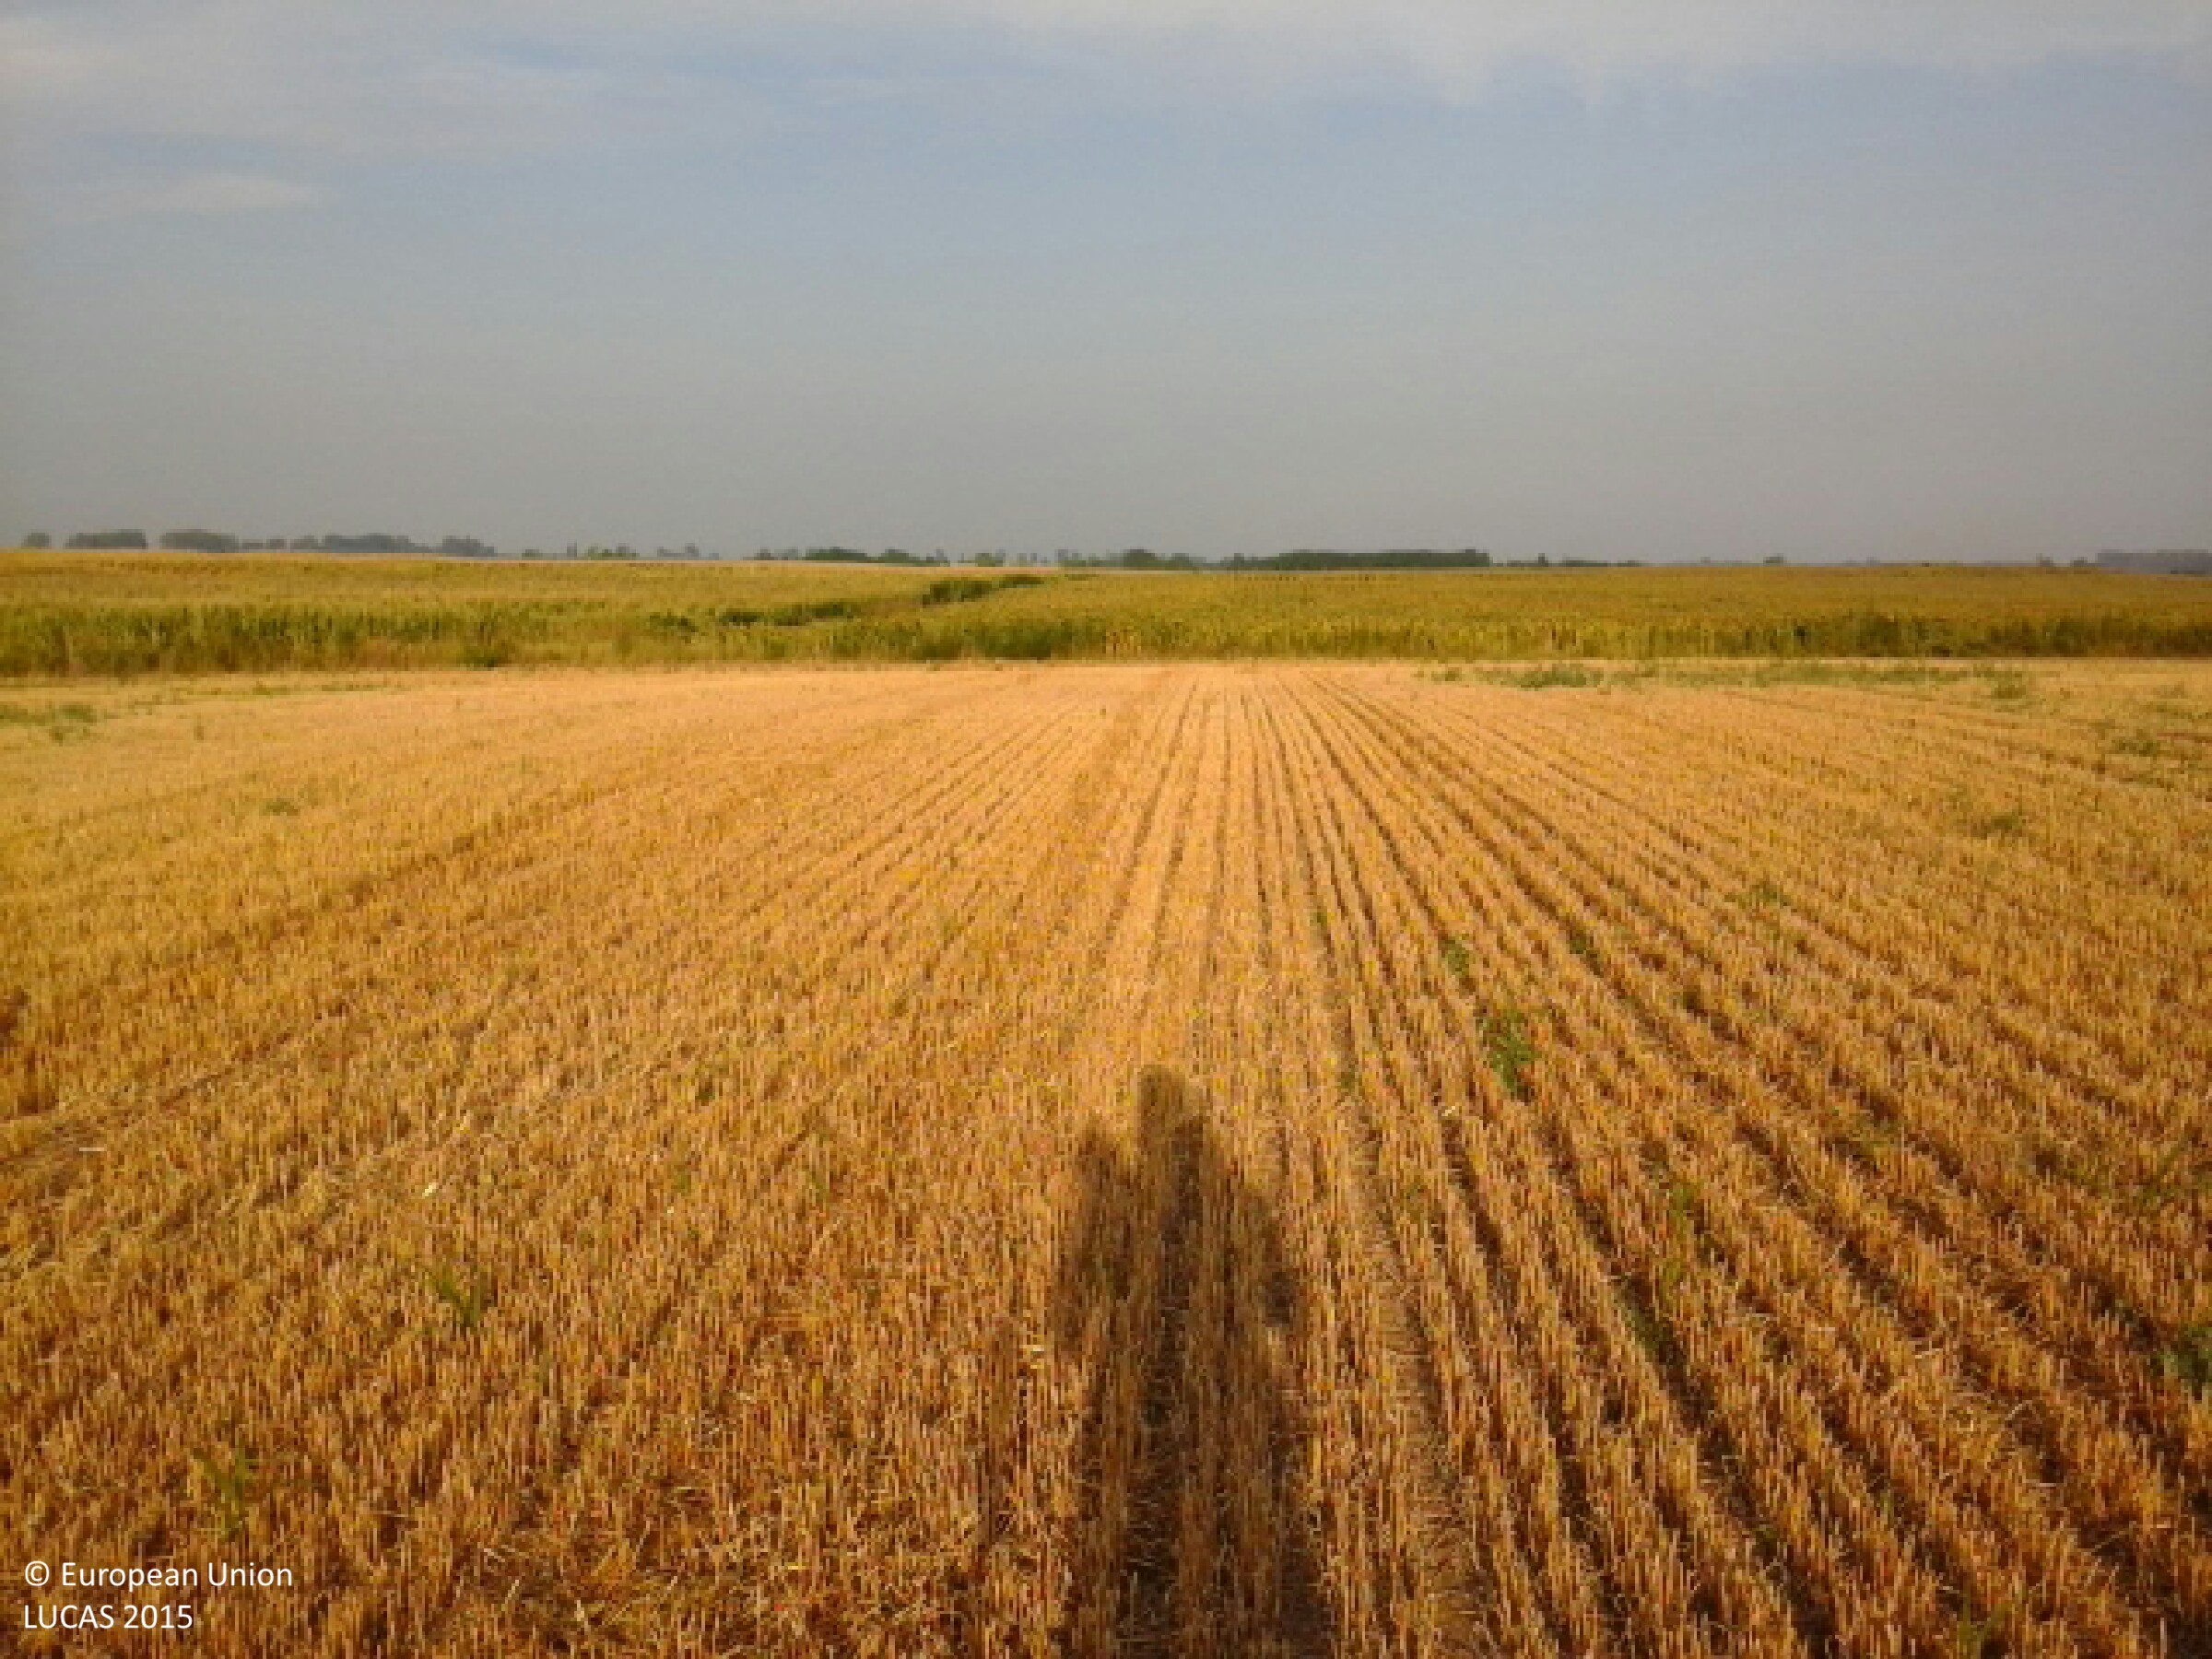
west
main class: Cropland
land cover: Triticale
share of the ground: 10 - 25 %
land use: Agriculture (excluding fallow land and kitchen gardens)
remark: Harvested field
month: August
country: HU
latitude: 47.7197
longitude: 17.9429
